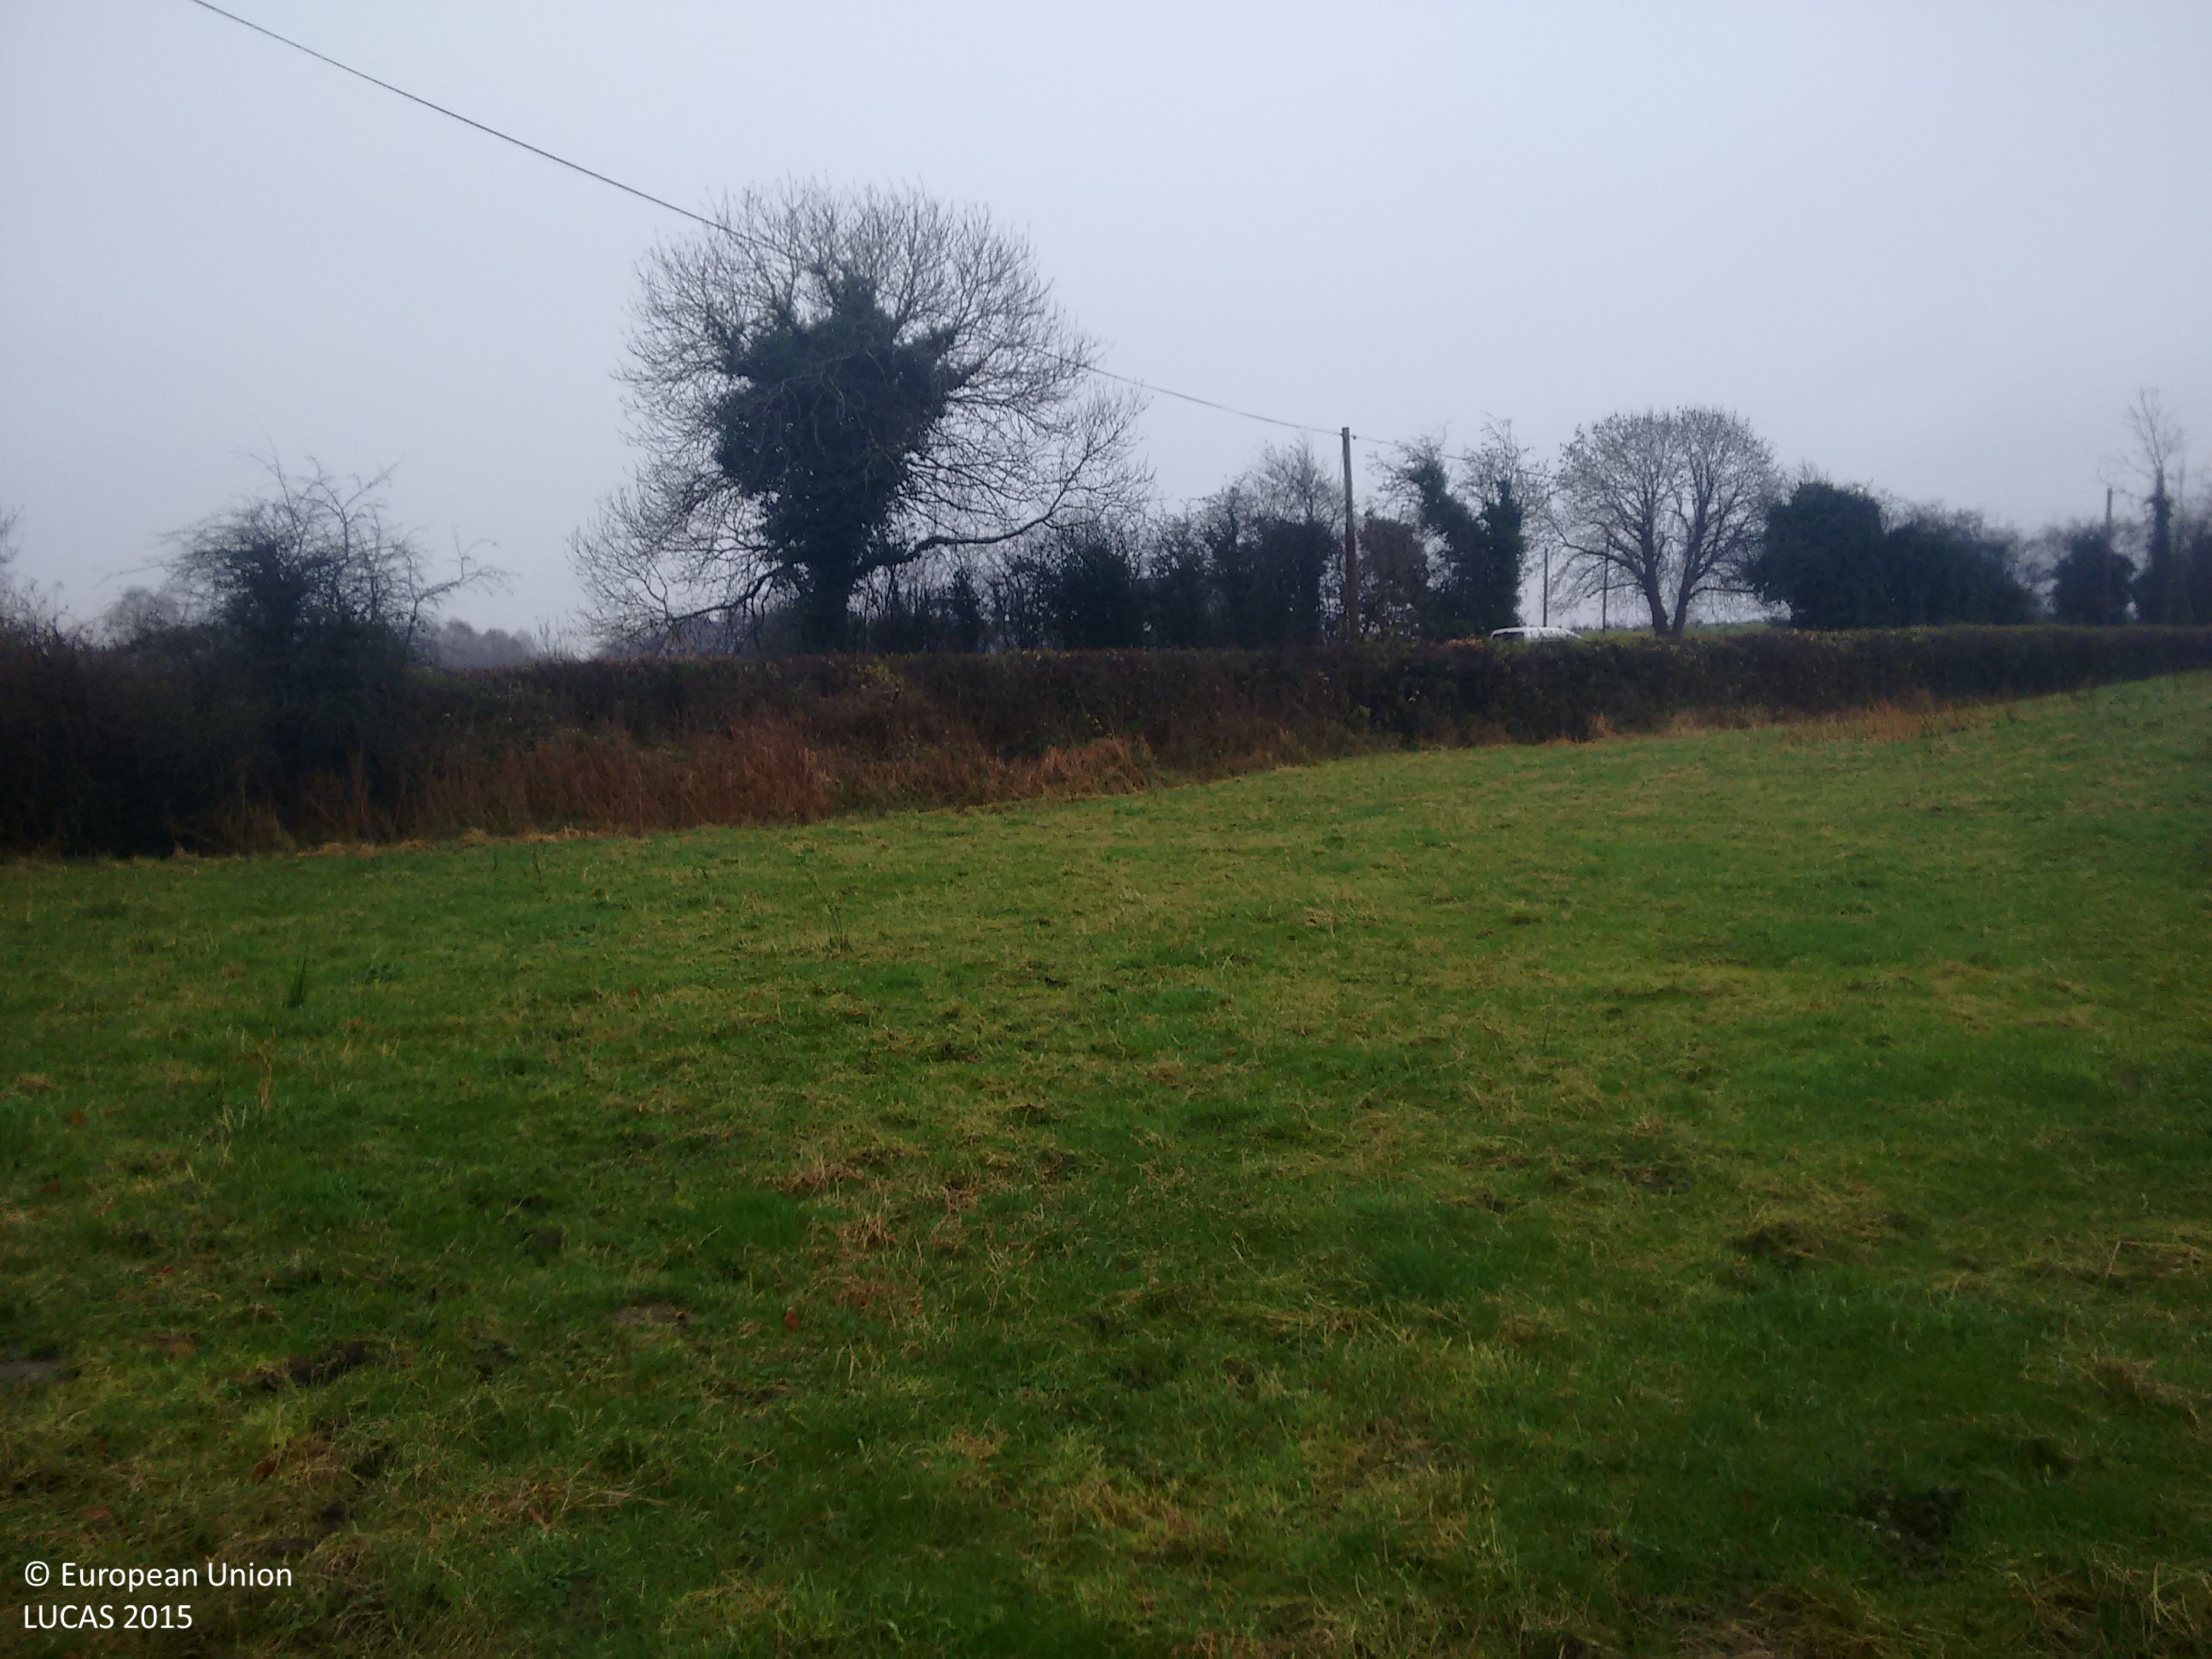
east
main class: Grassland
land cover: Grassland without tree/shrub cover
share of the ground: > 75 %
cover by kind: herbaceous plants 95 %, unconsolidated bare surface 5 %
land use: Agriculture (excluding fallow land and kitchen gardens)
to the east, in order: Paved roads, cycling and walking lanes; Managed hedges; Grassland without tree/shrub cover; Electric lines; Grassland without tree/shrub cover; Managed hedges; Grass margins; Paved roads, cycling and walking lanes; Grass margins; Broadleaved woodland; Fences; Broadleaved woodland; Fences; Grassland without tree/shrub cover; Artificial constructions in urban areas; Grassland without tree/shrub cover; Electric lines; Grassland without tree/shrub cover; Fences; Broadleaved woodland
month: December
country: IE
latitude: 54.1703
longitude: -7.2909
